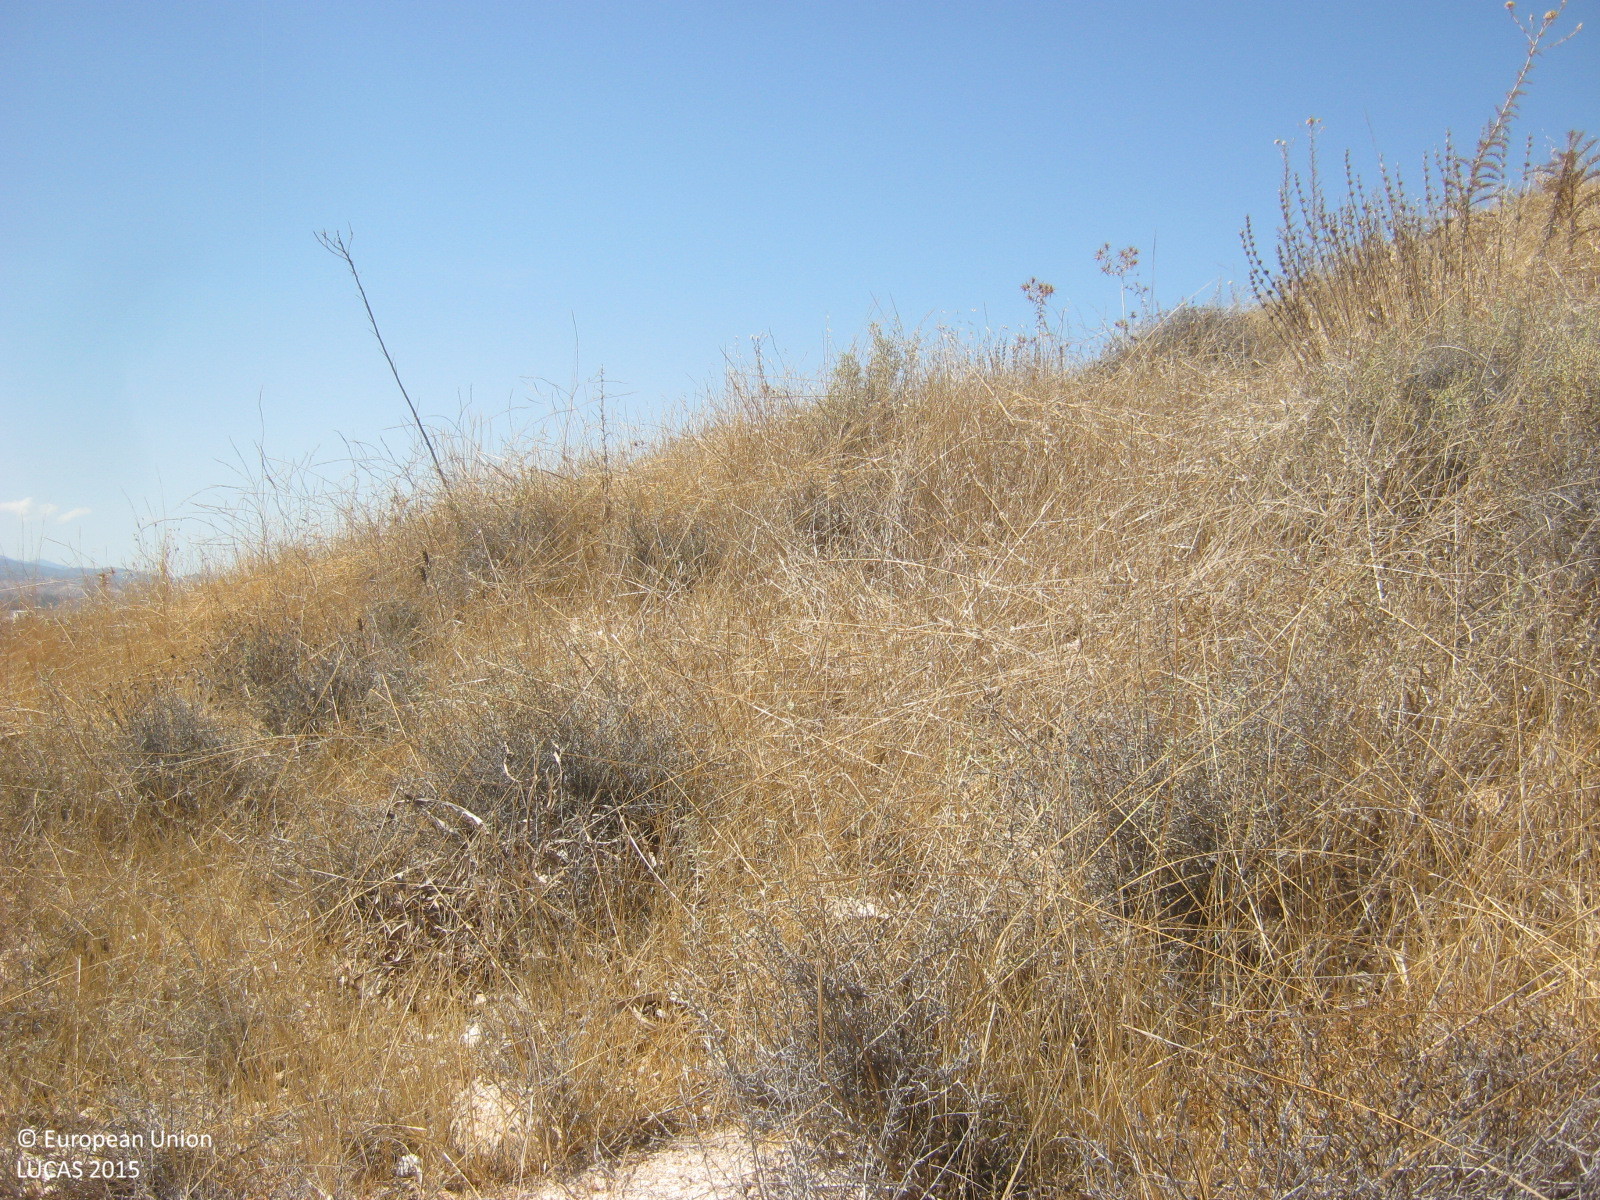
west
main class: Grassland
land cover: Grassland without tree/shrub cover
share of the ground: 25 - 50 %
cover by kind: unconsolidated bare surface 55 %, herbaceous plants 45 %
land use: Semi-natural and natural areas not in use
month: April
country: CY
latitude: 34.9954
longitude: 33.3832
